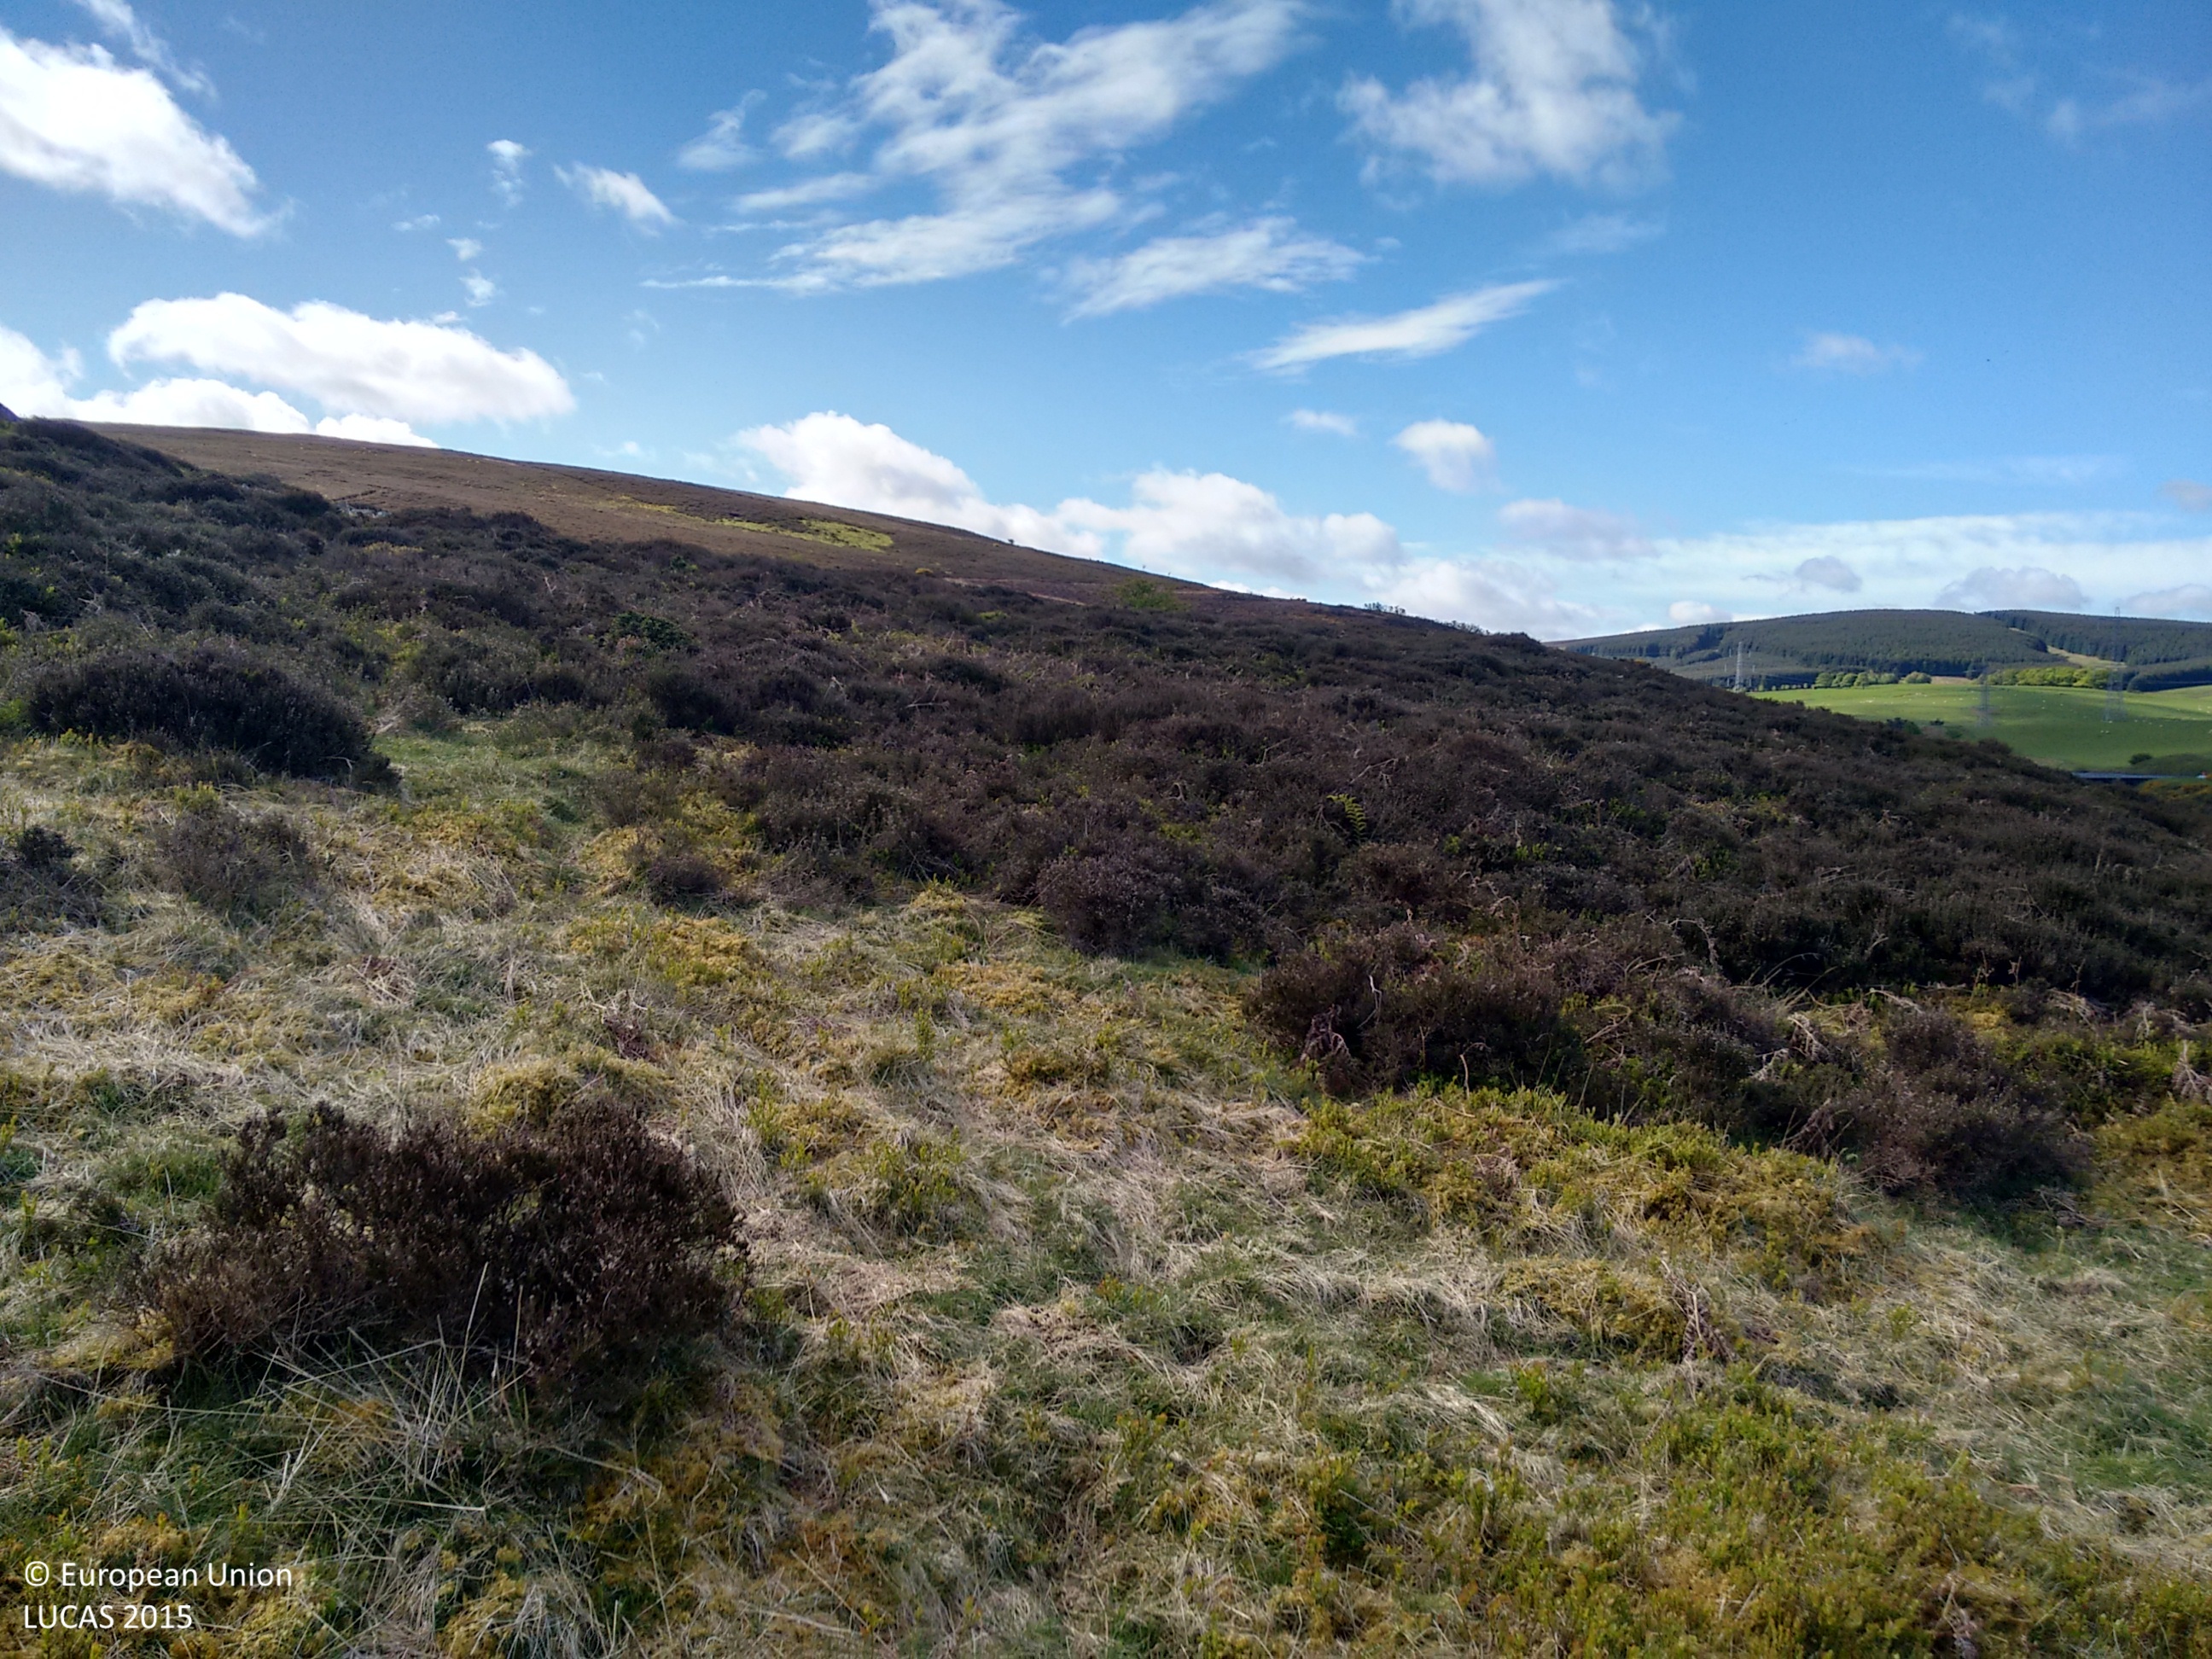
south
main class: Shrubland
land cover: Shrubland without tree cover
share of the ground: > 75 %
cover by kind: shrubs 80 %, herbaceous plants 20 %
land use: Agriculture (excluding fallow land and kitchen gardens)
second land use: Other primary production
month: June
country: GB
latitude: 55.8536
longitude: -2.7963
